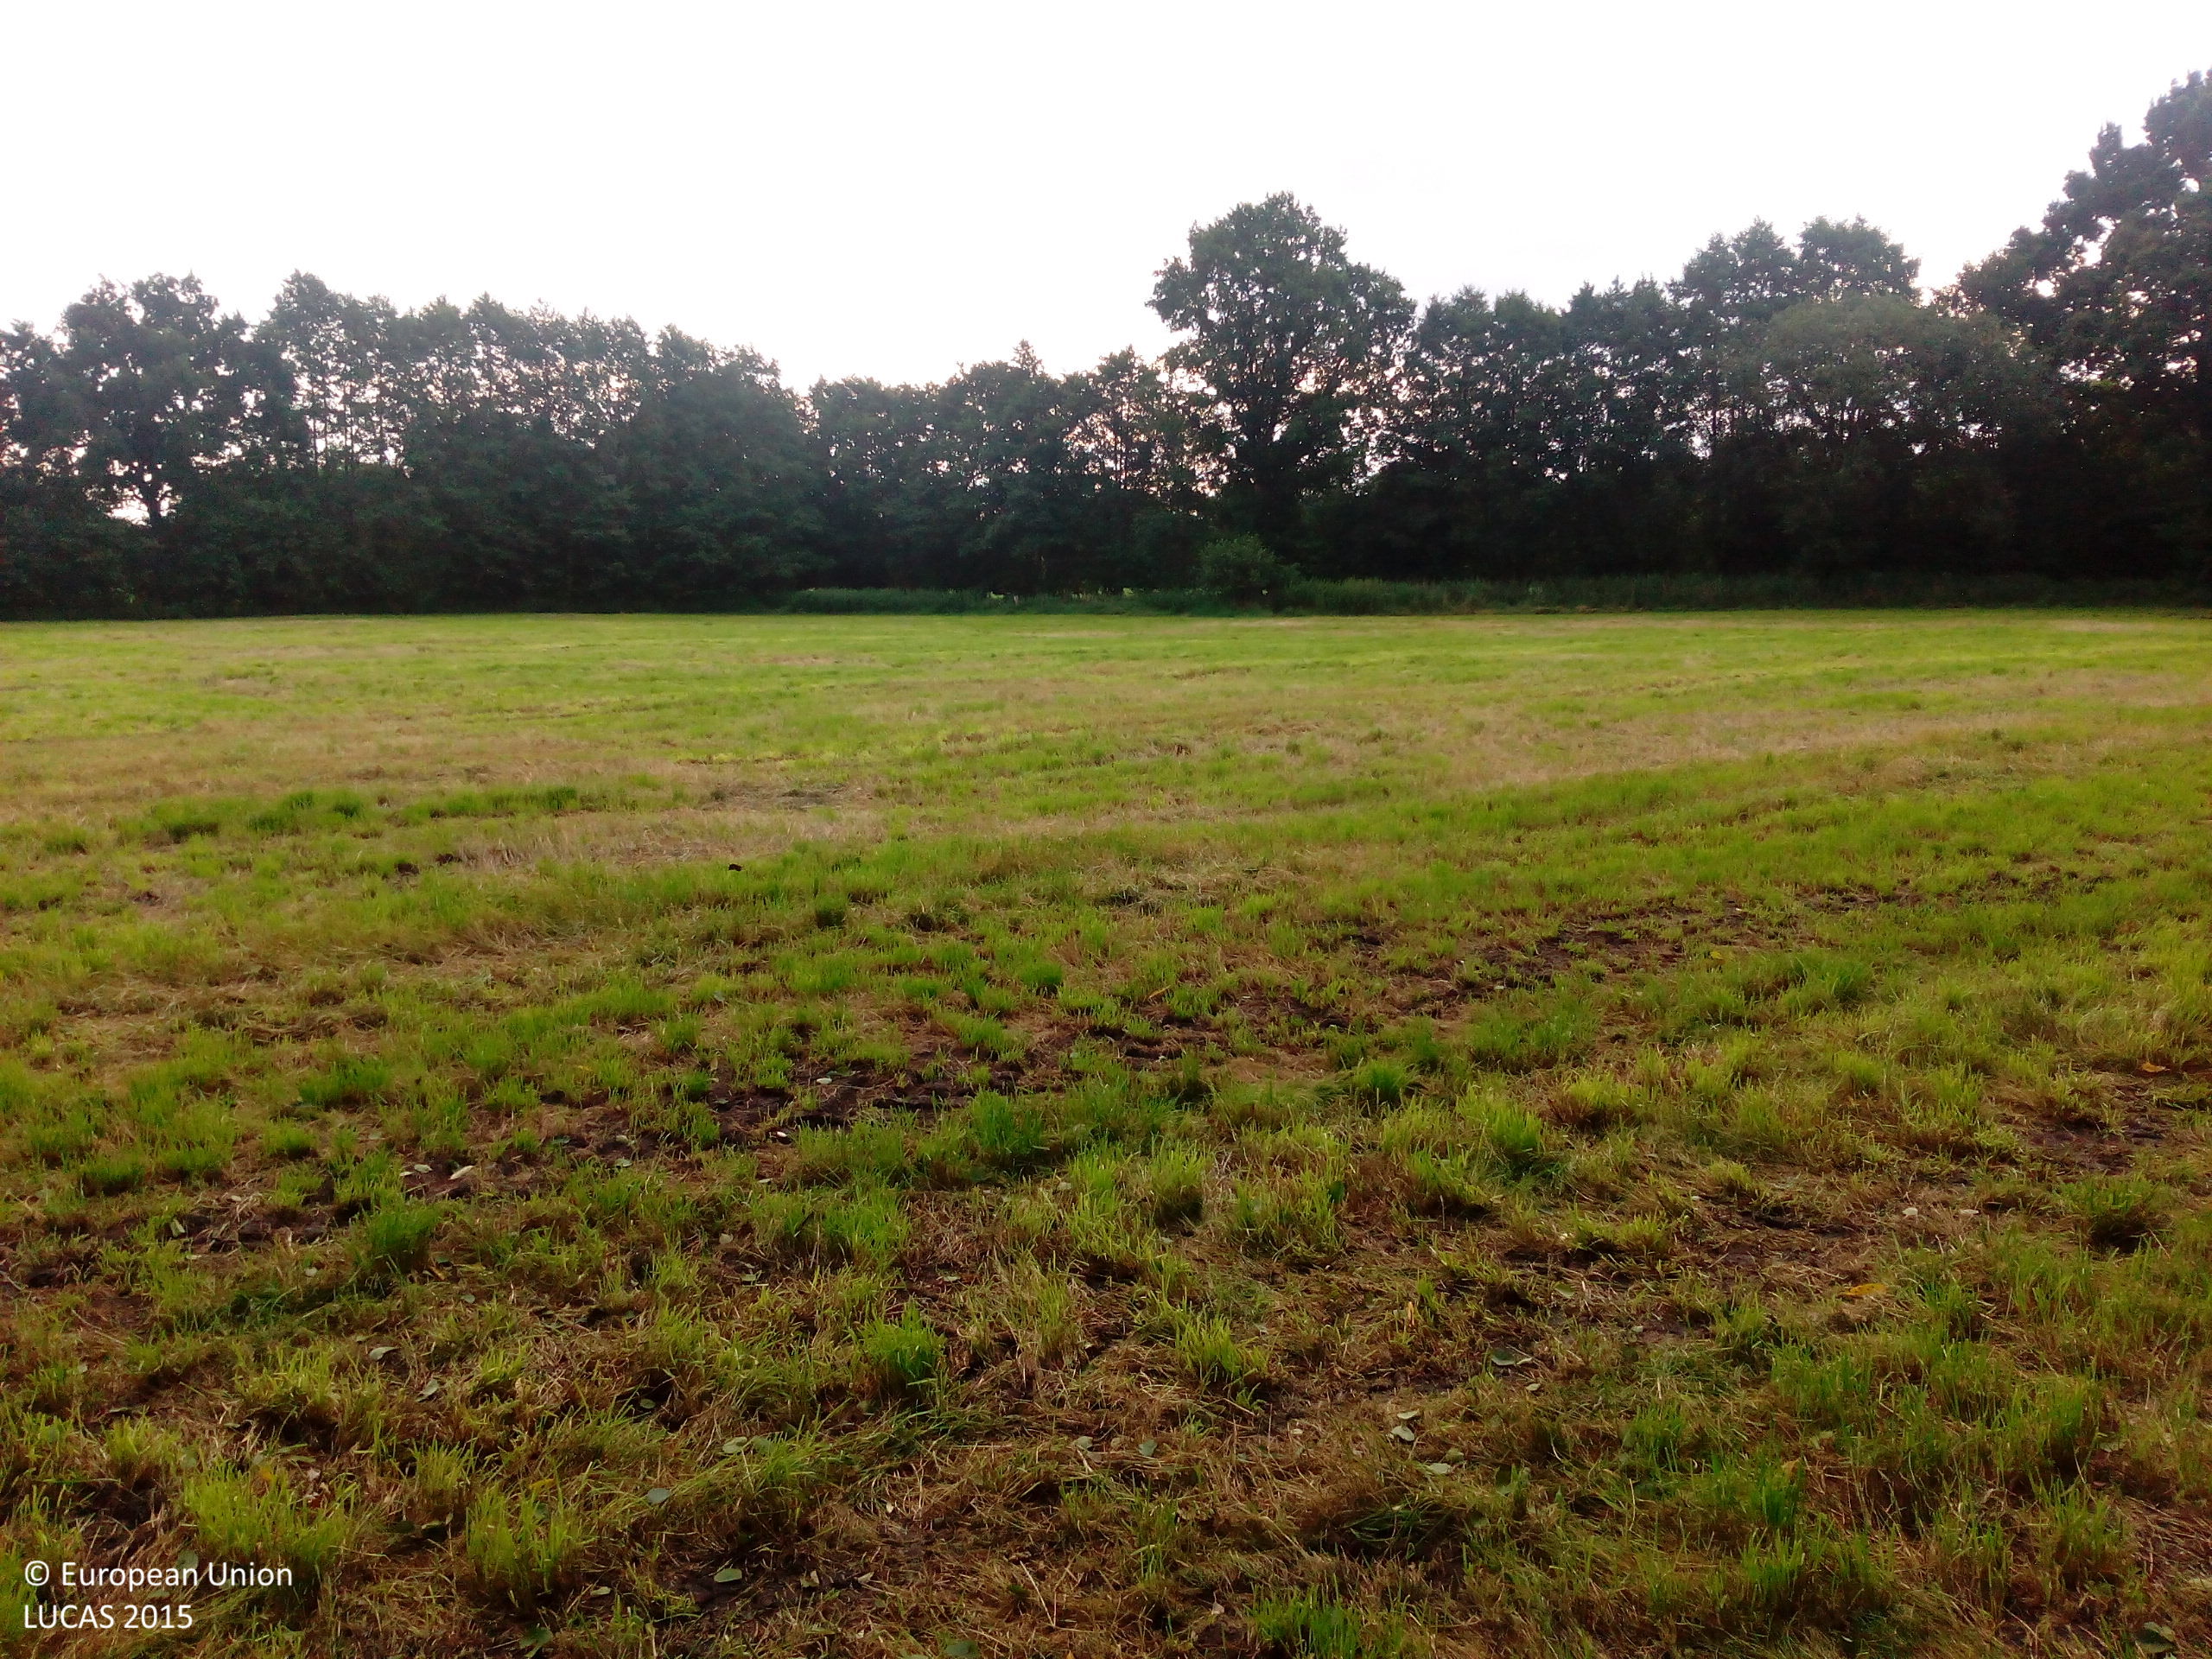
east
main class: Grassland
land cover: Grassland without tree/shrub cover
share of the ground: > 75 %
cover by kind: herbaceous plants 80 %, unconsolidated bare surface 20 %
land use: Agriculture (excluding fallow land and kitchen gardens)
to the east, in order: Grassland without tree/shrub cover; Fences; Tracks; Fences; Broadleaved woodland; Fences; Grassland without tree/shrub cover
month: August
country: DE
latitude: 53.8692
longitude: 9.9240
